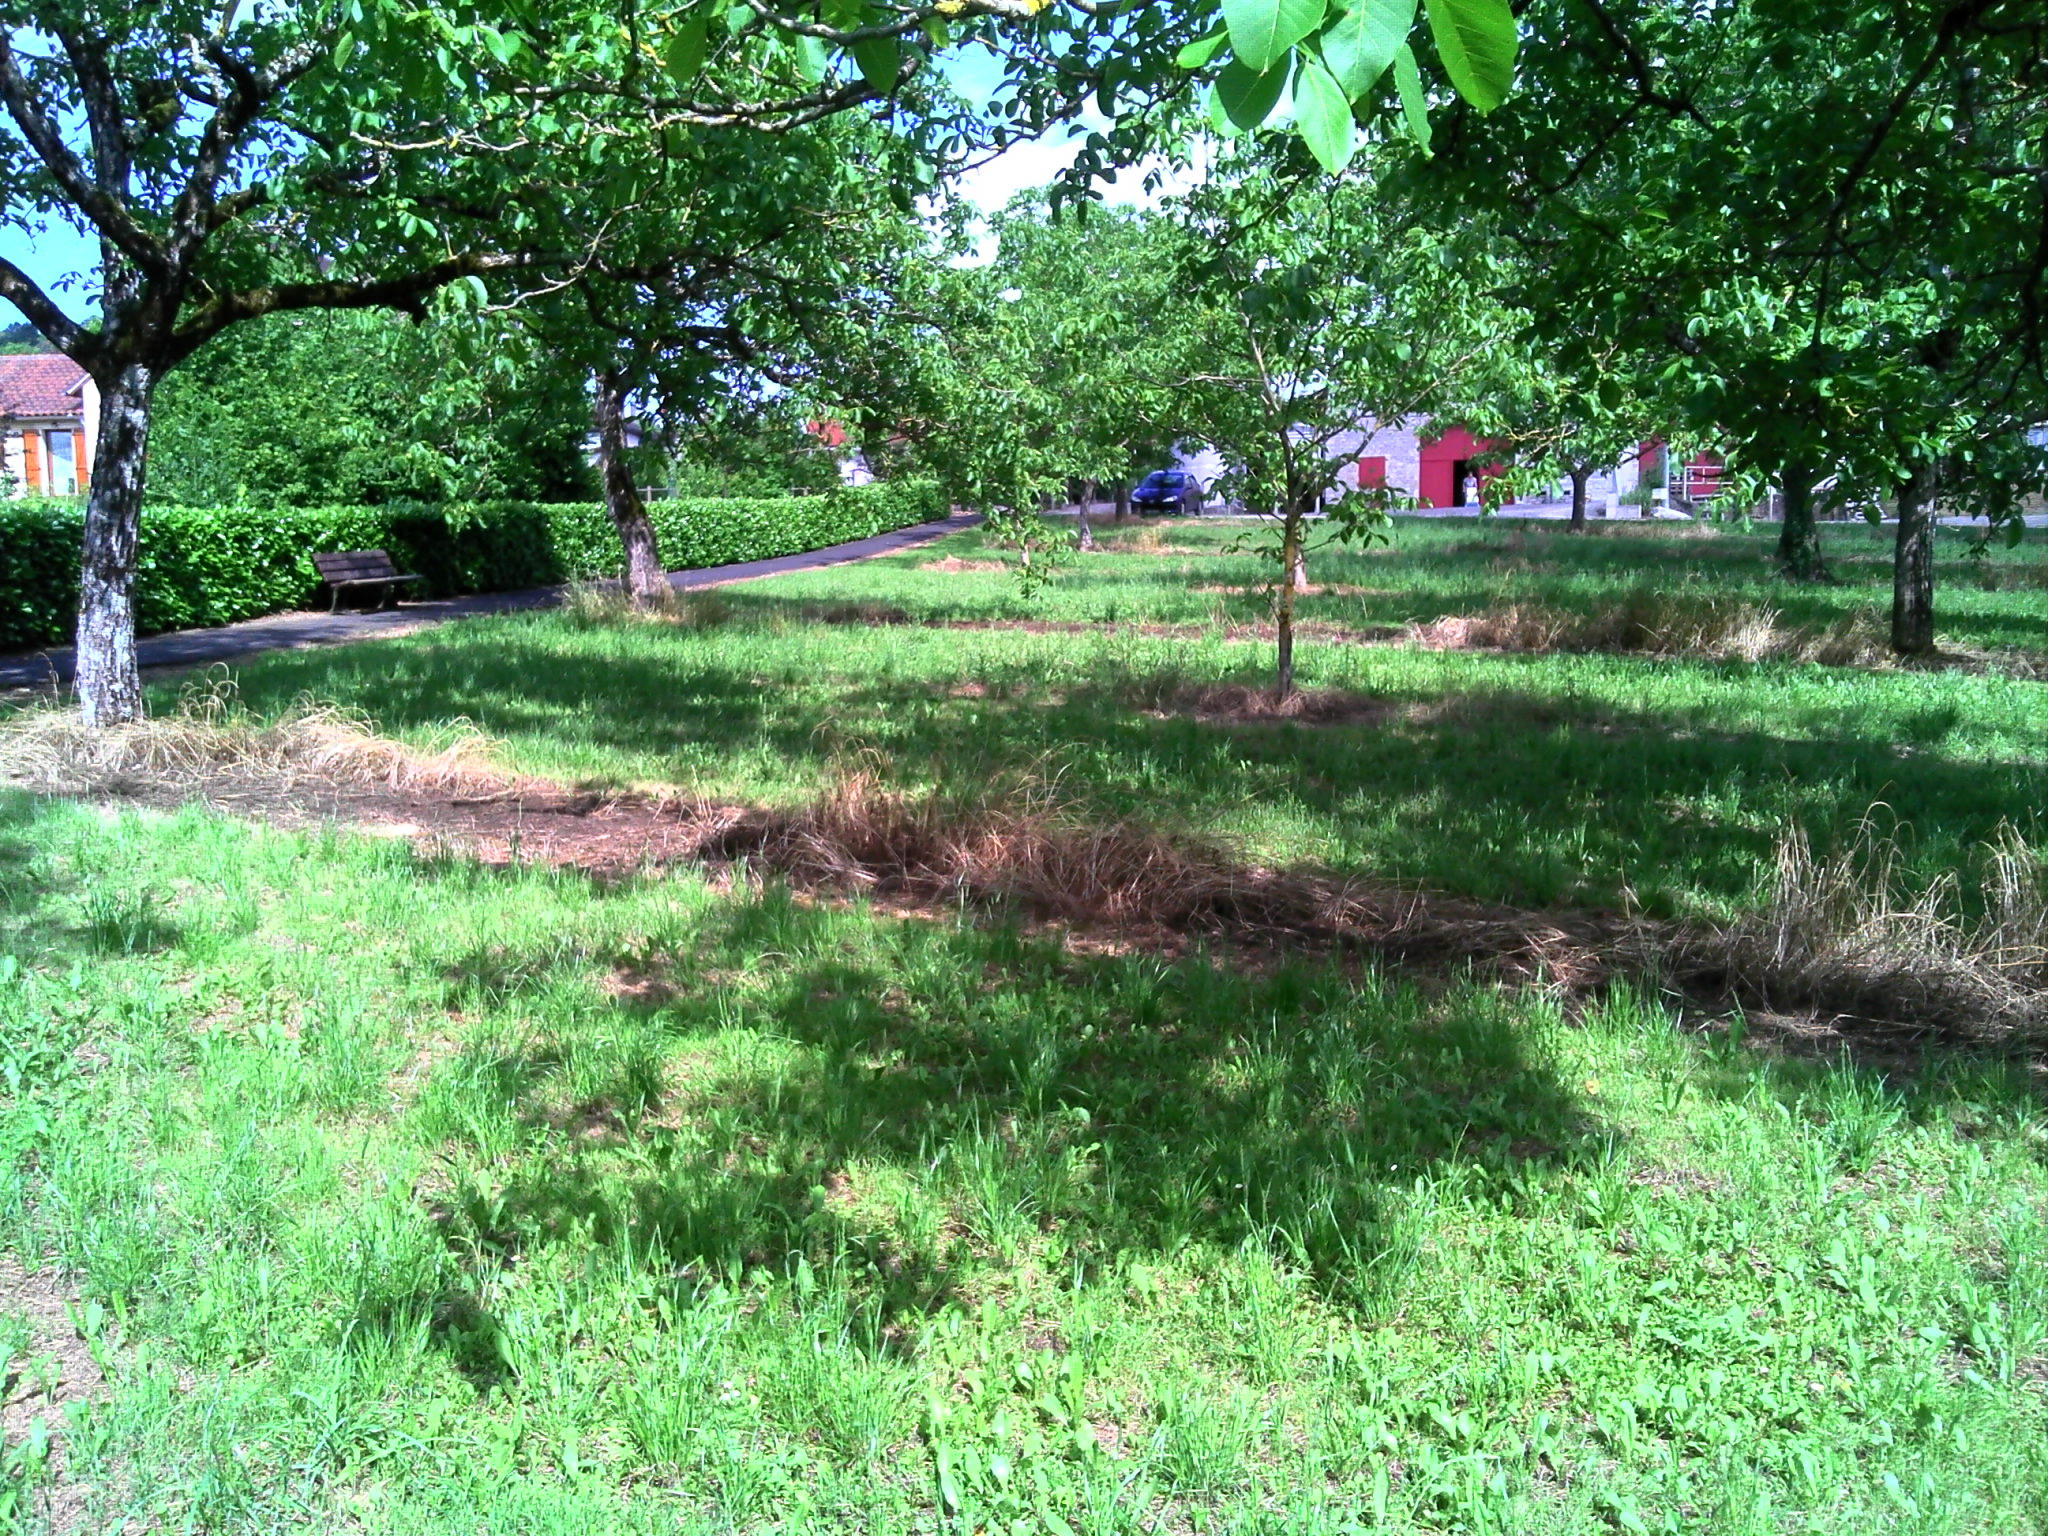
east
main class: Cropland
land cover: Nuts trees
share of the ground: > 75 %
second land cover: Grassland without tree/shrub cover
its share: 10 - 25 %
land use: Agriculture (excluding fallow land and kitchen gardens)
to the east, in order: Nuts trees; Grassland without tree/shrub cover; Artificial constructions in urban areas; Other fresh vegetables; Managed hedges; Grassland without tree/shrub cover
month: June
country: FR
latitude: 44.9195
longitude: 1.8778
